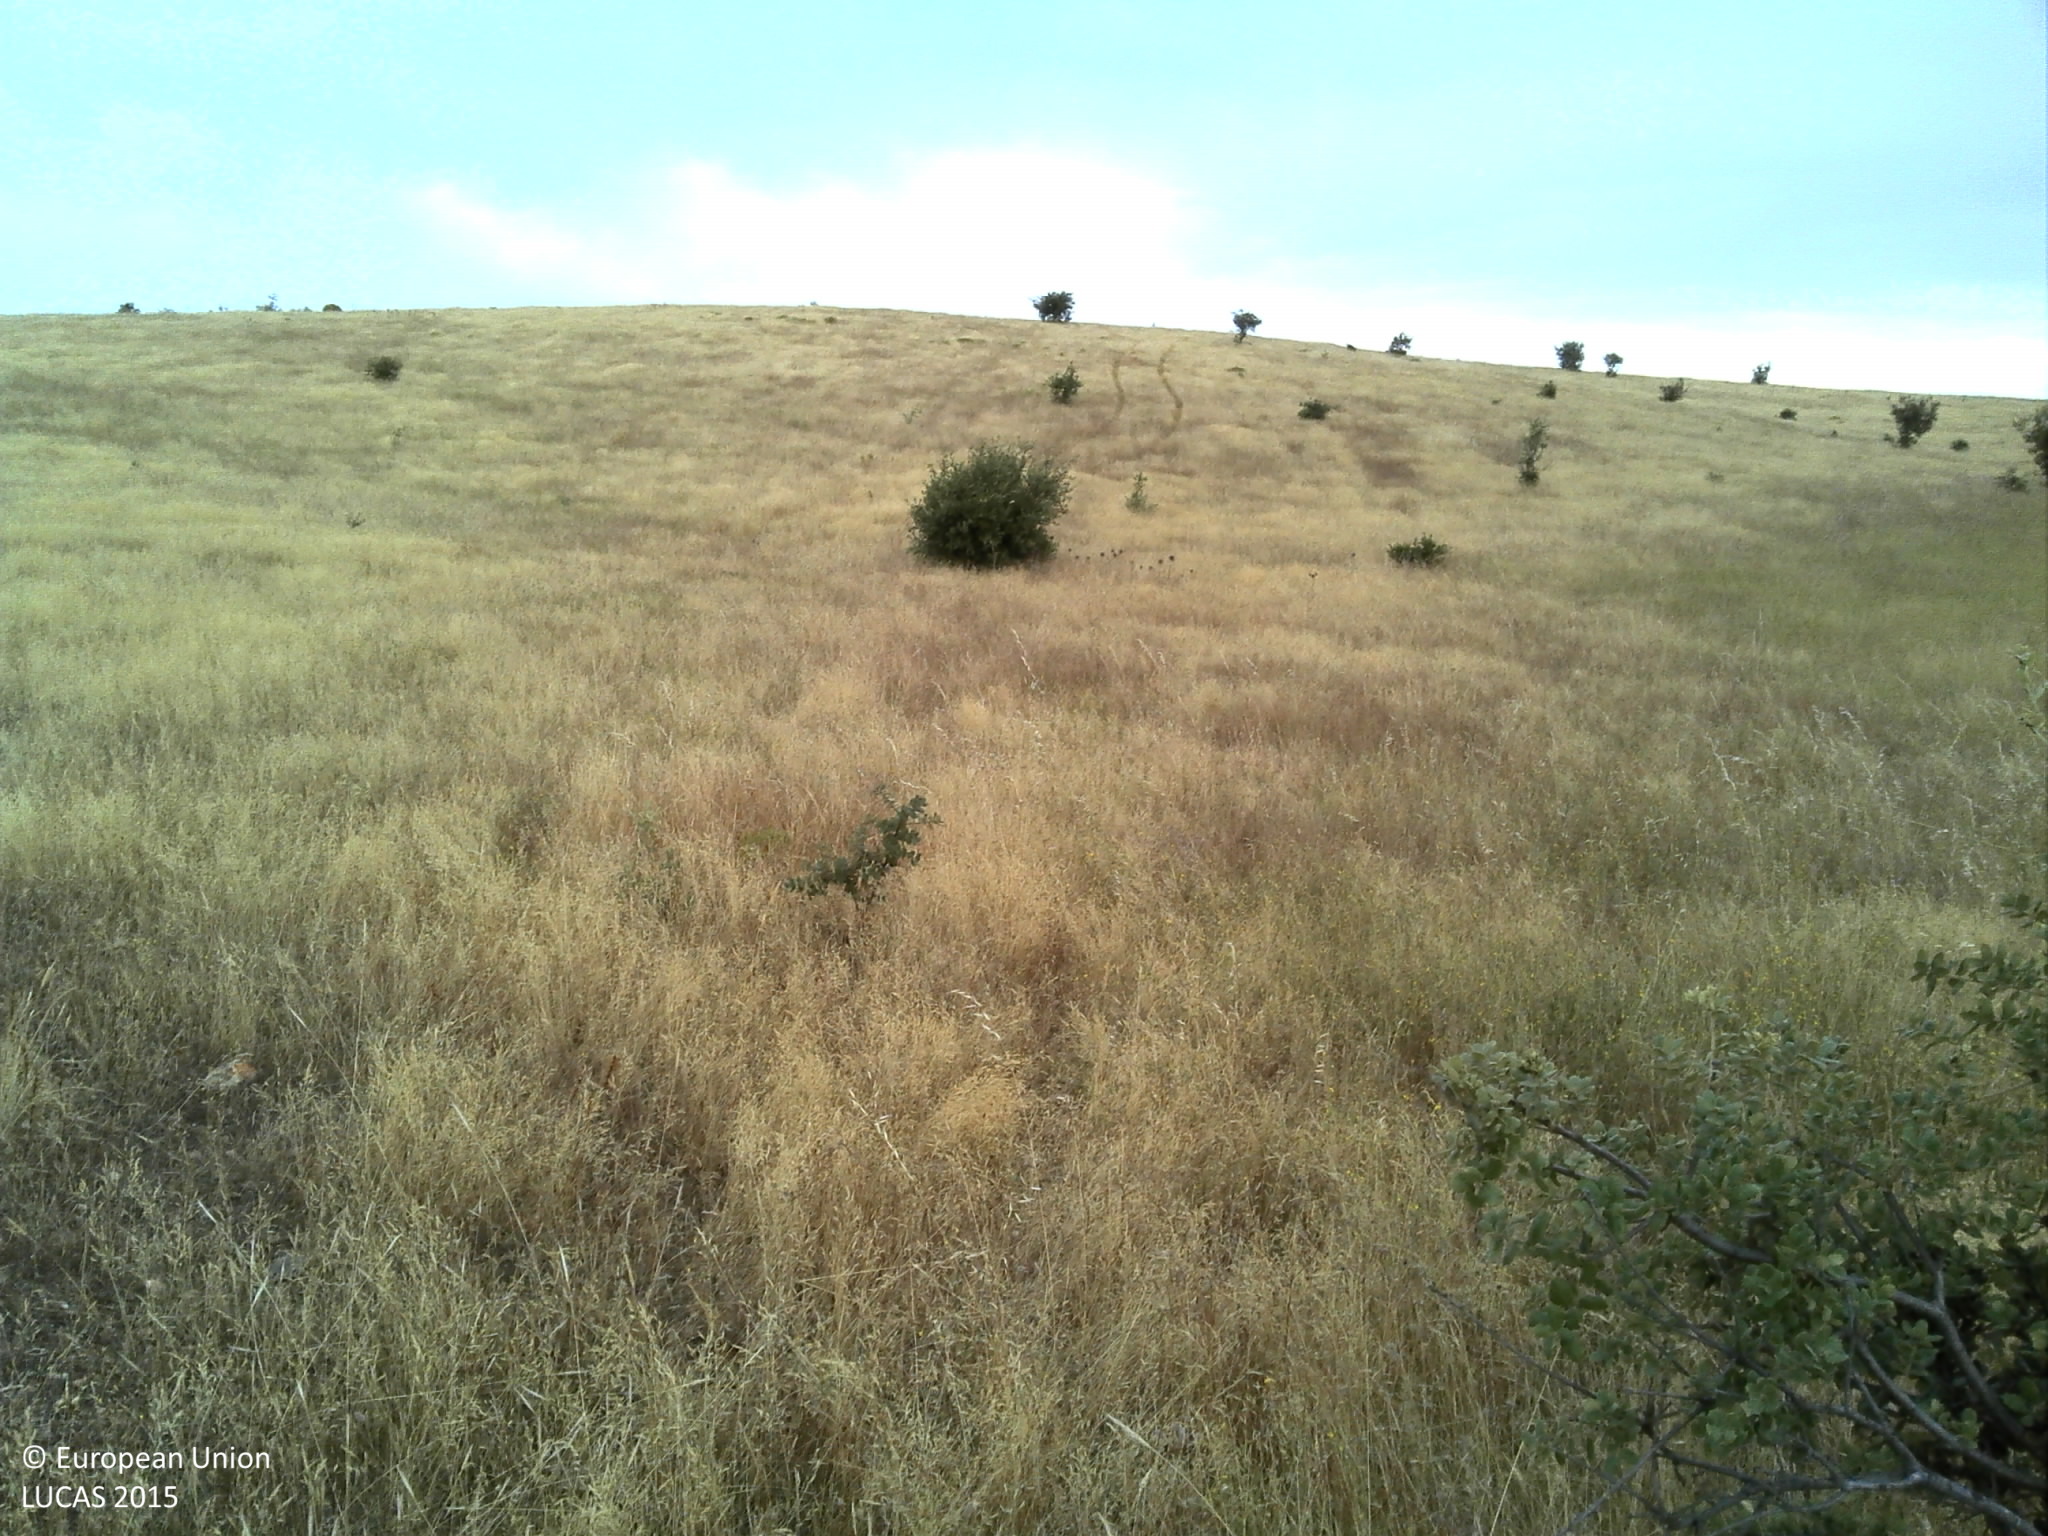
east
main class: Grassland
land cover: Grassland with sparse tree/shrub cover
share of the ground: > 75 %
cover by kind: herbaceous plants 95 %, broadleaved forest trees 5 %
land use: Agriculture (excluding fallow land and kitchen gardens)
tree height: < 5 m
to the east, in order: Grassland with sparse tree/shrub cover; Grassland without tree/shrub cover; Tracks; Fences; Broadleaved woodland
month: June
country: PT
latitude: 37.7165
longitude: -7.5183
